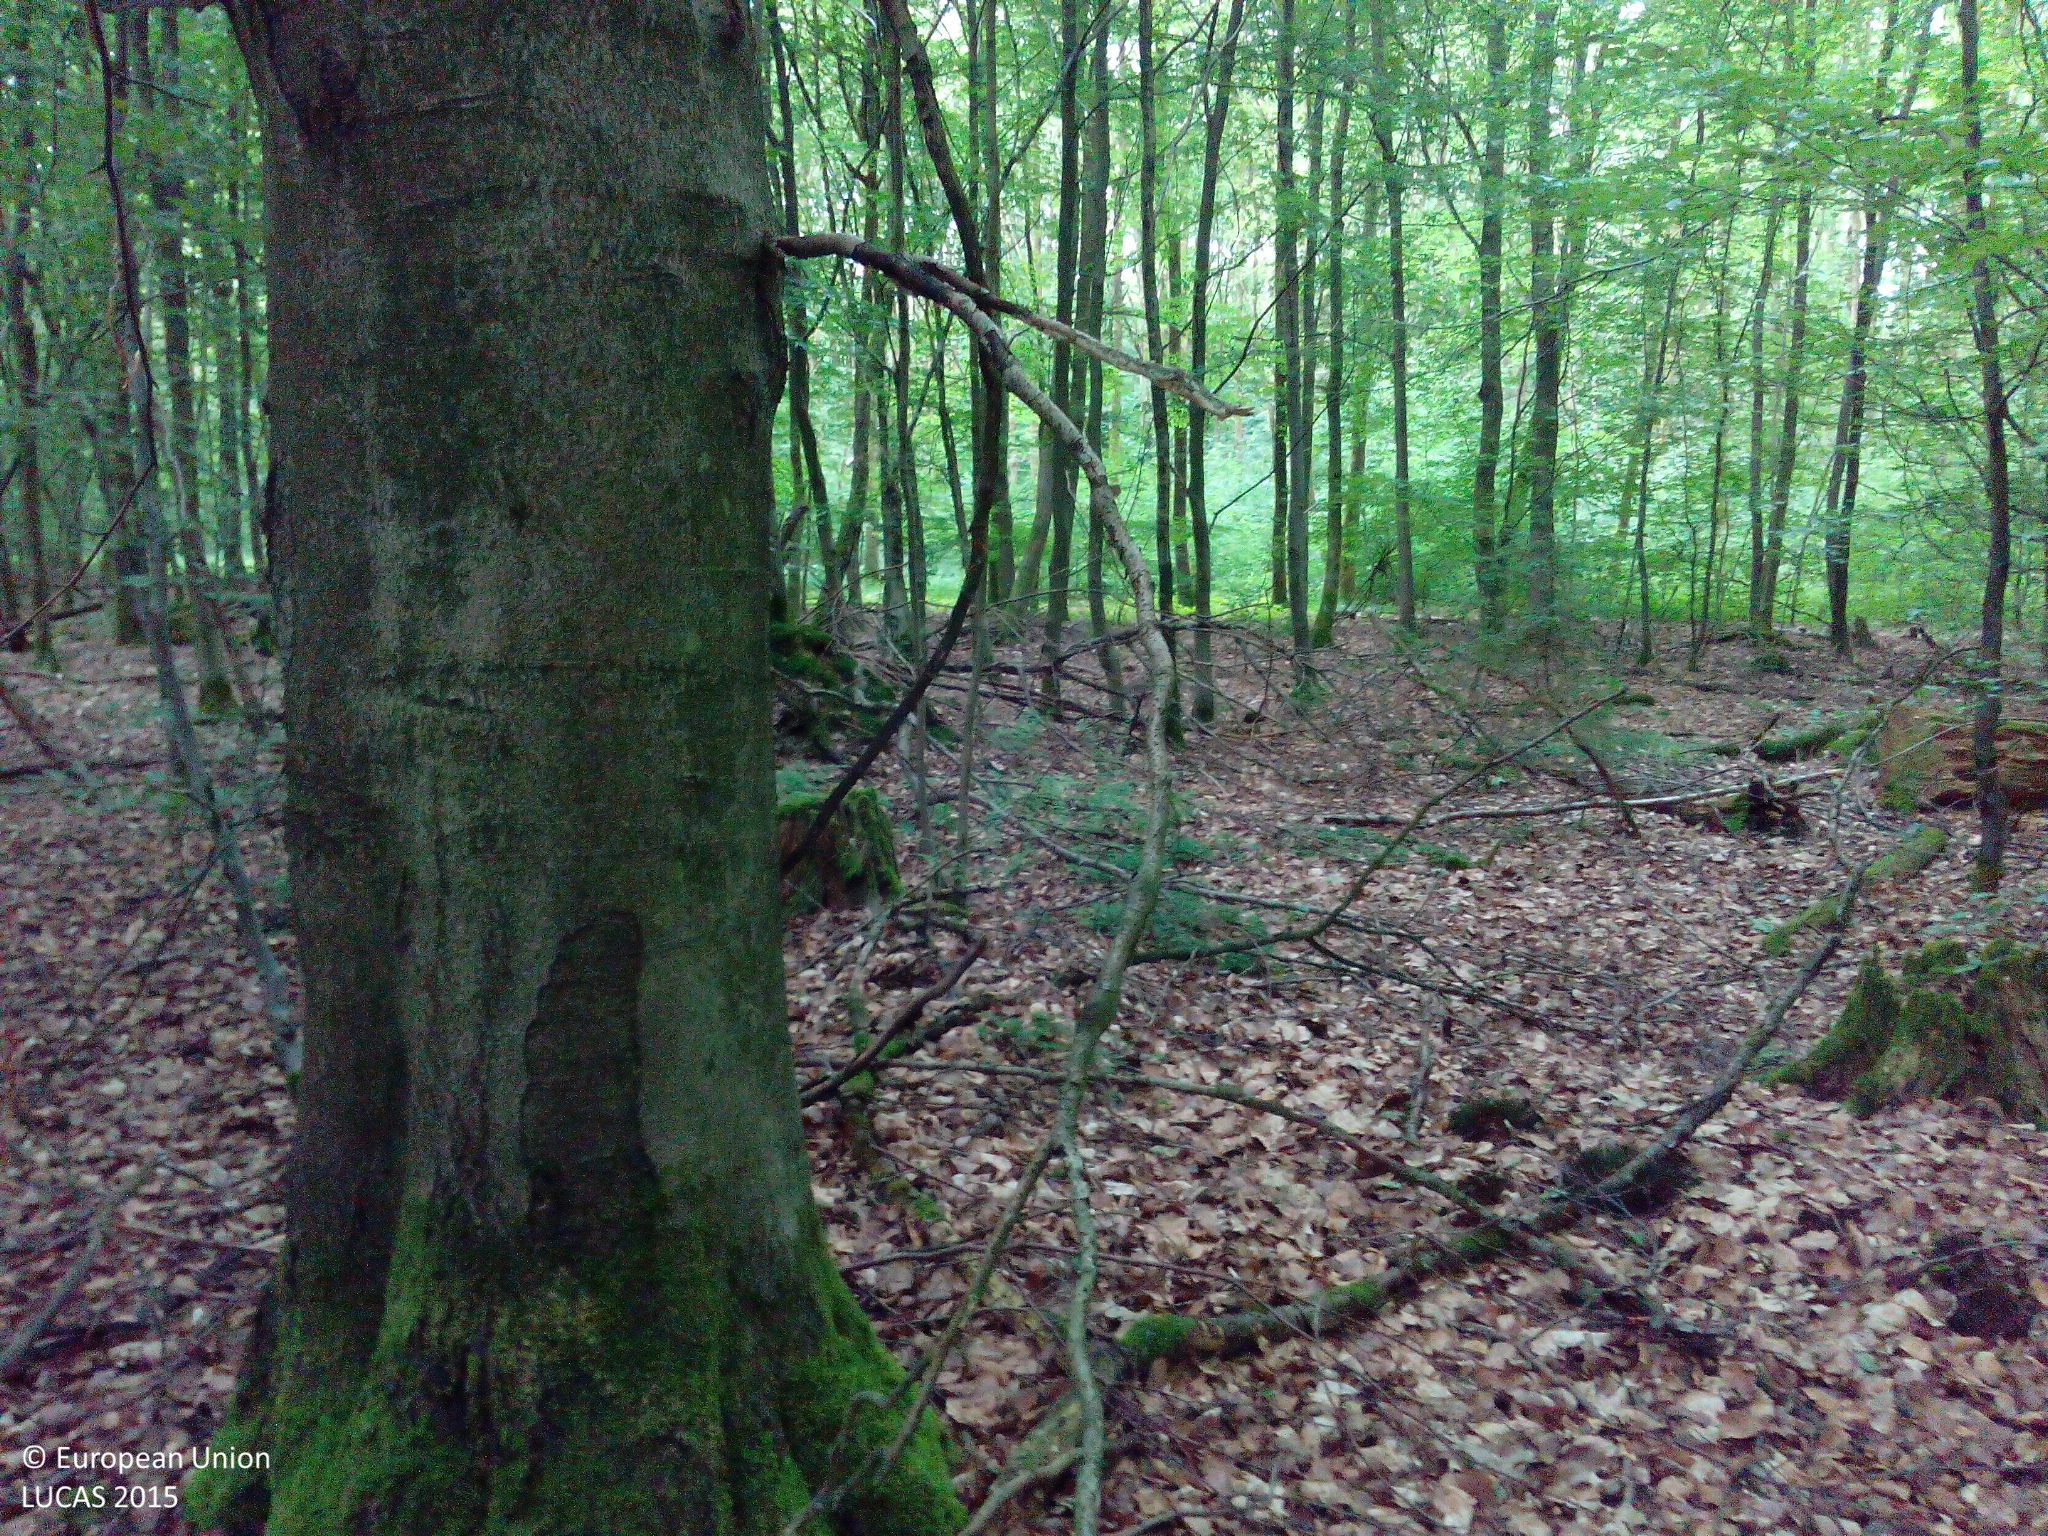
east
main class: Woodland
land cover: Spruce dominated mixed woodland
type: hemiboreal forest and nemoral coniferous forest and mixed broadleaved-coniferous forest
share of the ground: > 75 %
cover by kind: broadleaved forest trees 70 %, coniferous forest trees 25 %, unconsolidated bare surface 5 %
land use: Forestry
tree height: > 5 m
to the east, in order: Spruce dominated mixed woodland; Broadleaved woodland; Tracks; Spruce dominated coniferous woodland; Broadleaved woodland
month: June
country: DE
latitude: 49.2835
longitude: 9.4091
